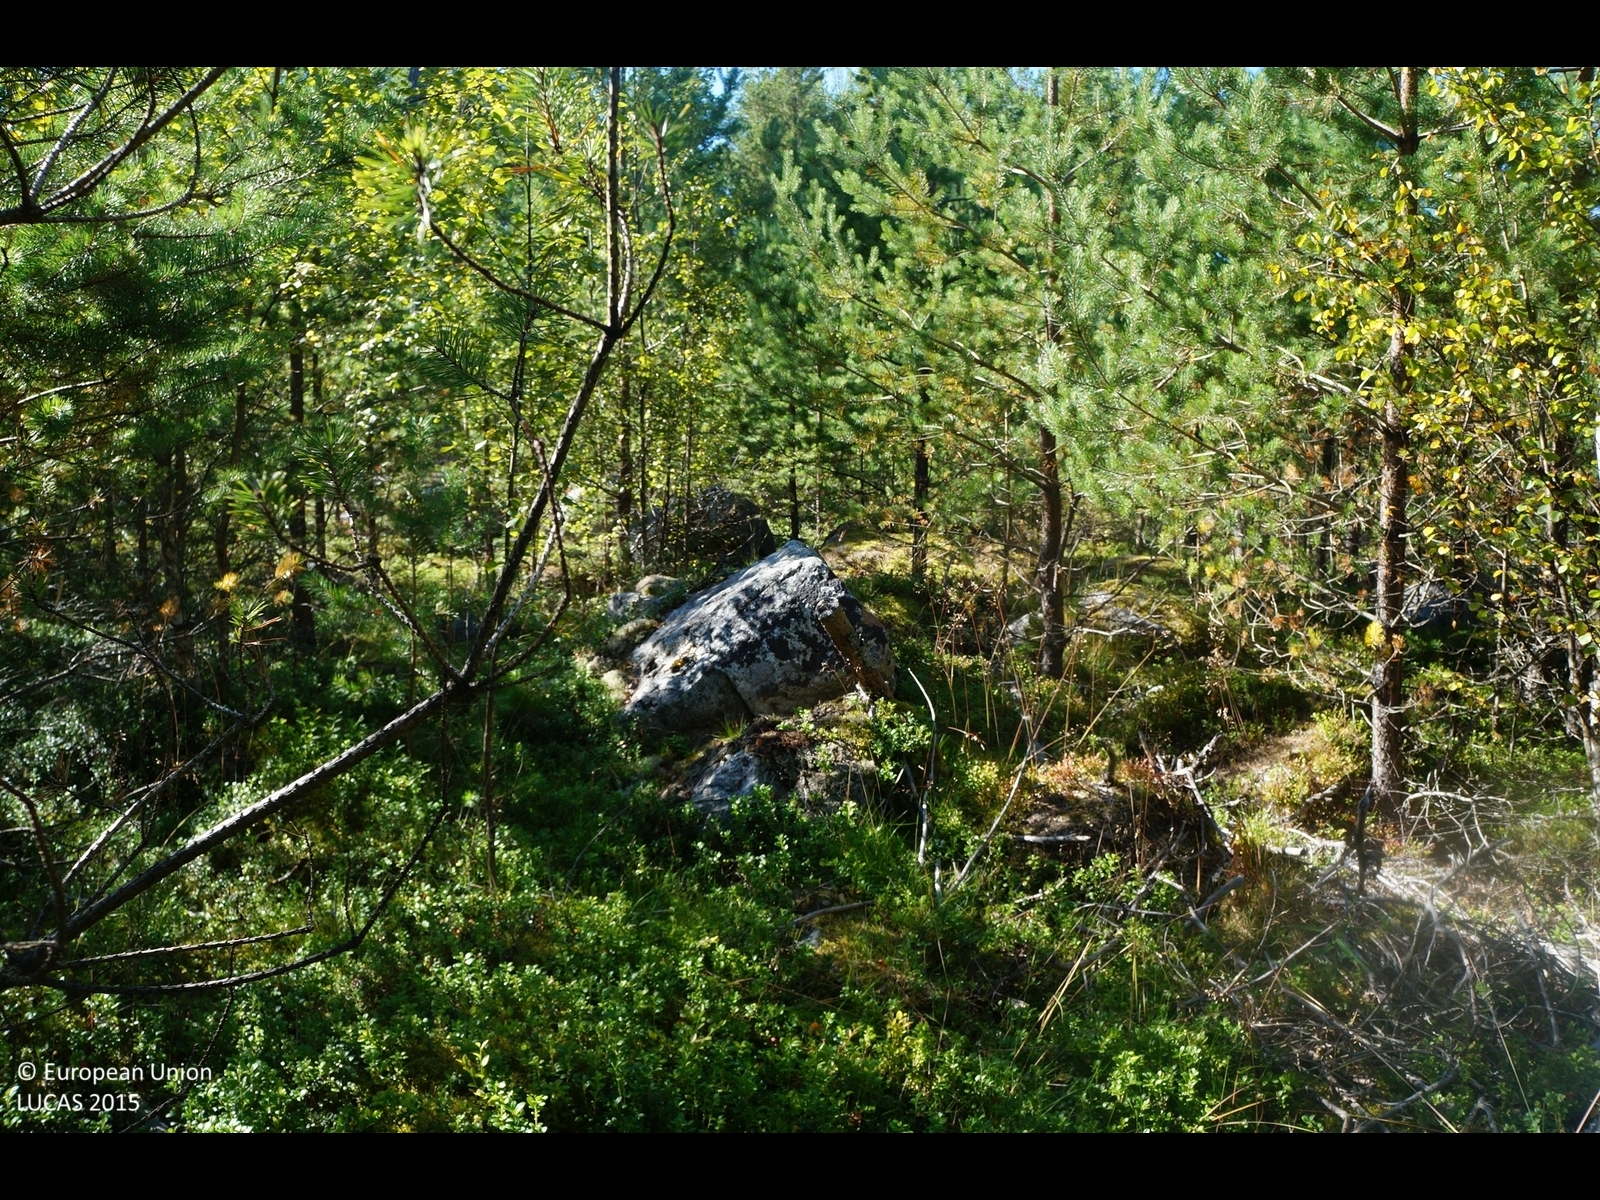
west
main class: Woodland
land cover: Pine dominated mixed woodland
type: boreal forest
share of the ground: 50 - 75 %
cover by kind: coniferous forest trees 50 %, broadleaved forest trees 20 %, shrubs 15 %, lichens and mosses 10 %, consolidated bare surface 5 %
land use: Forestry
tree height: > 5 m
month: August
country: FI
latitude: 63.7704
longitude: 22.7636
